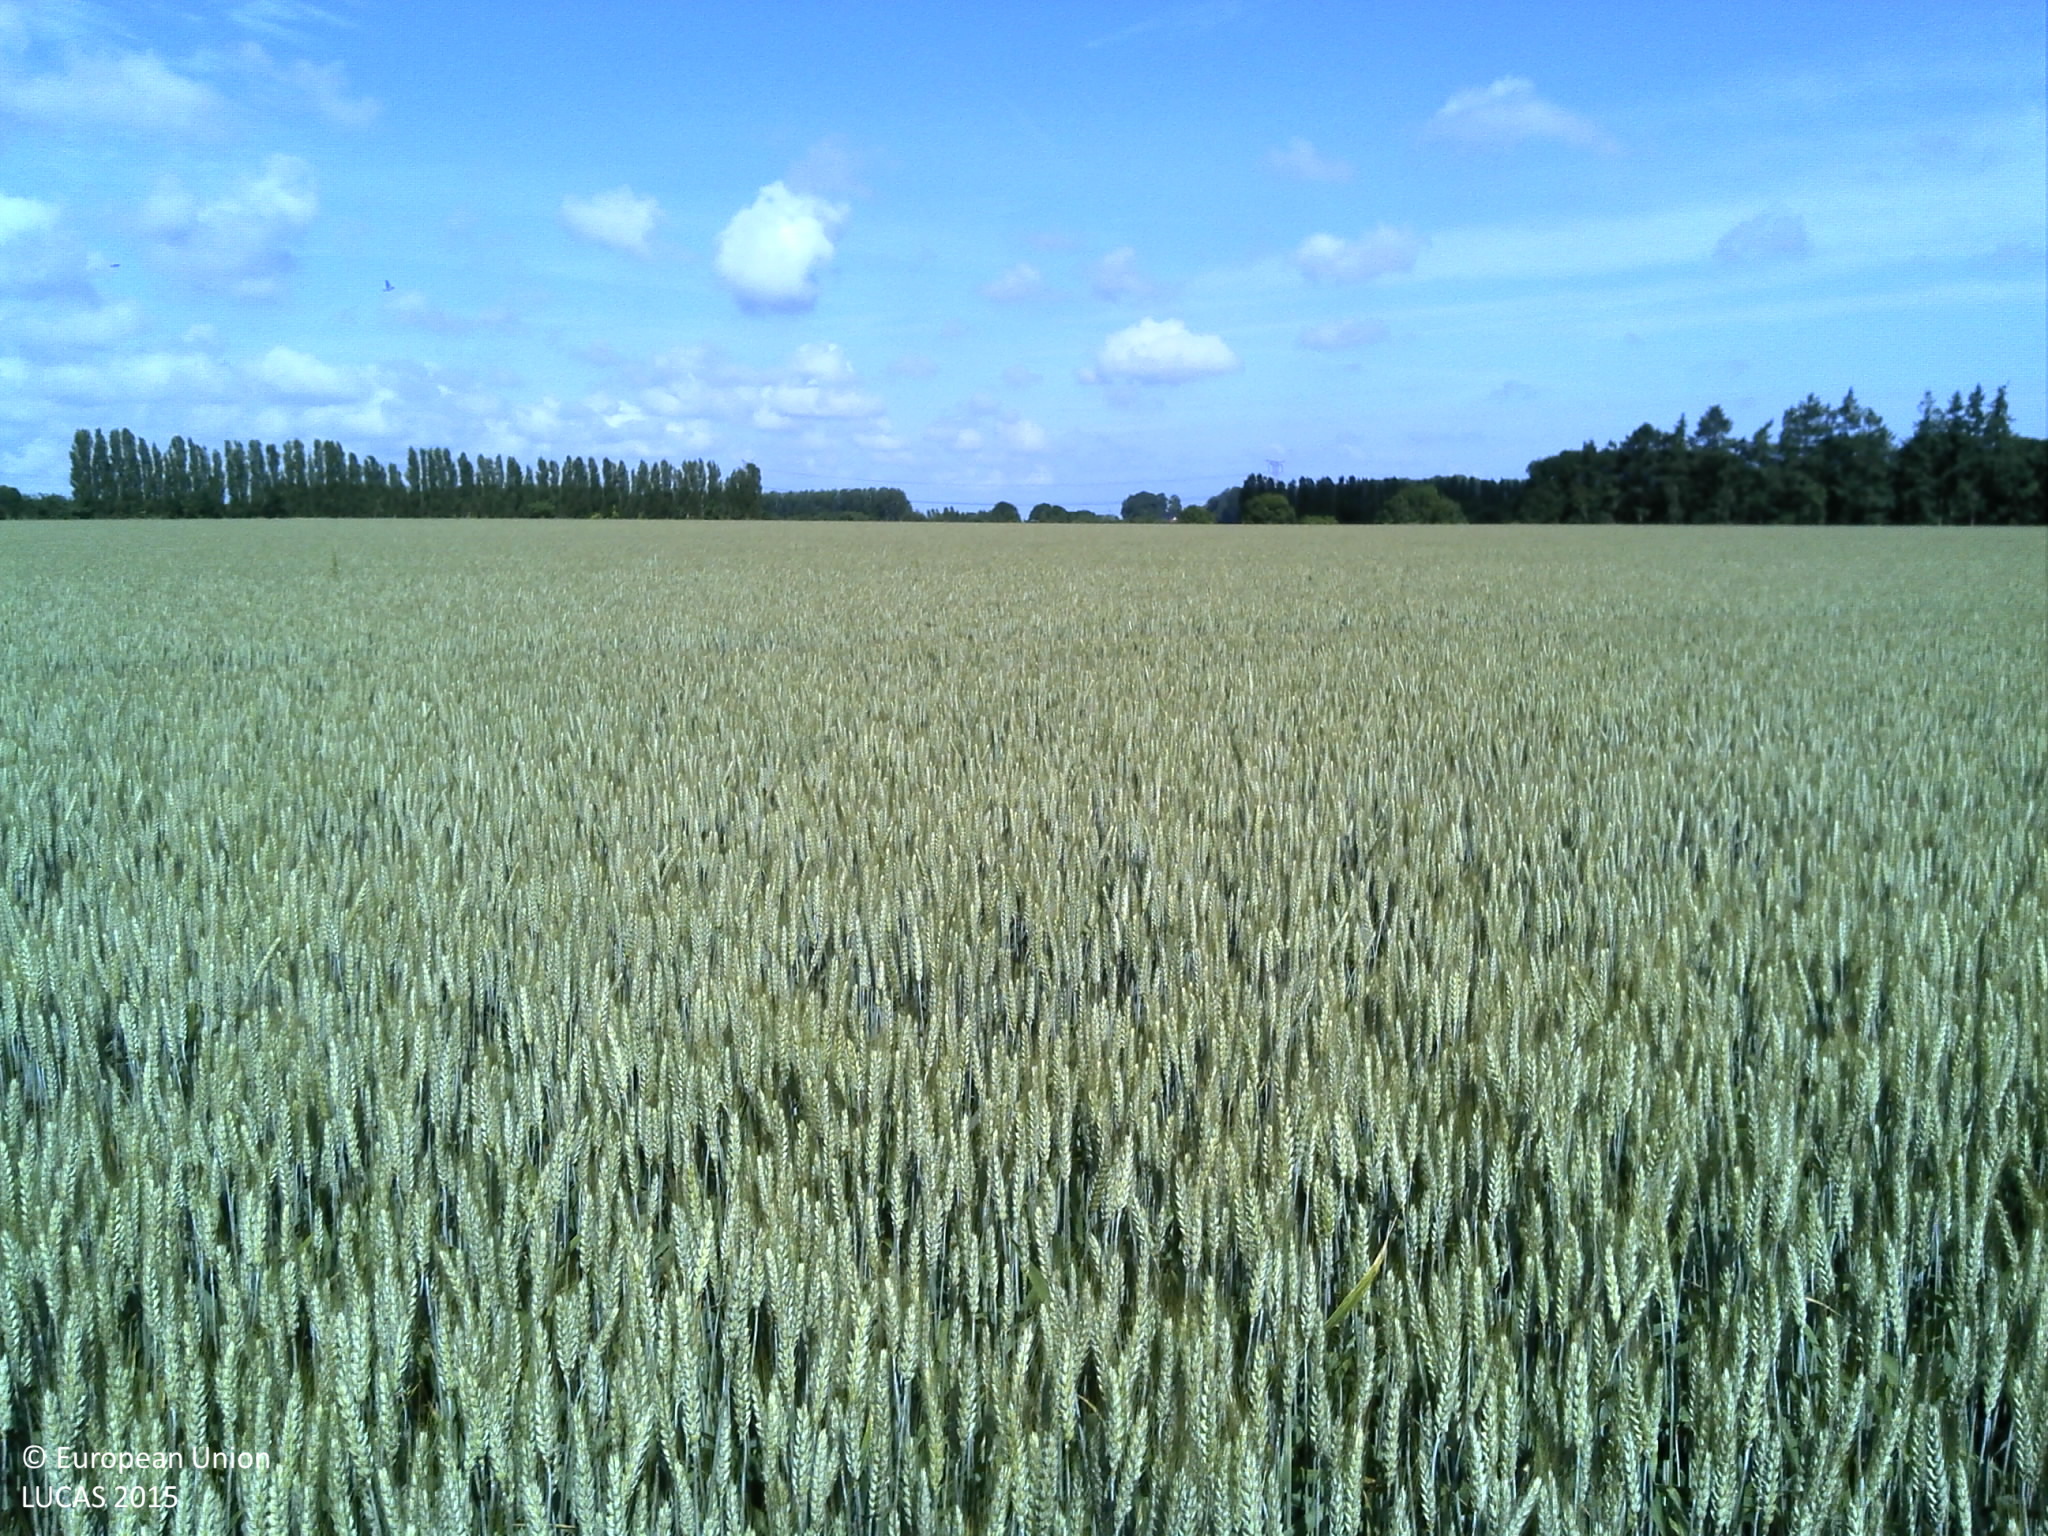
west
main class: Cropland
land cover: Rape and turnip rape
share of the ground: > 75 %
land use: Agriculture (excluding fallow land and kitchen gardens)
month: June
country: FR
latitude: 49.8395
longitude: 1.1490
